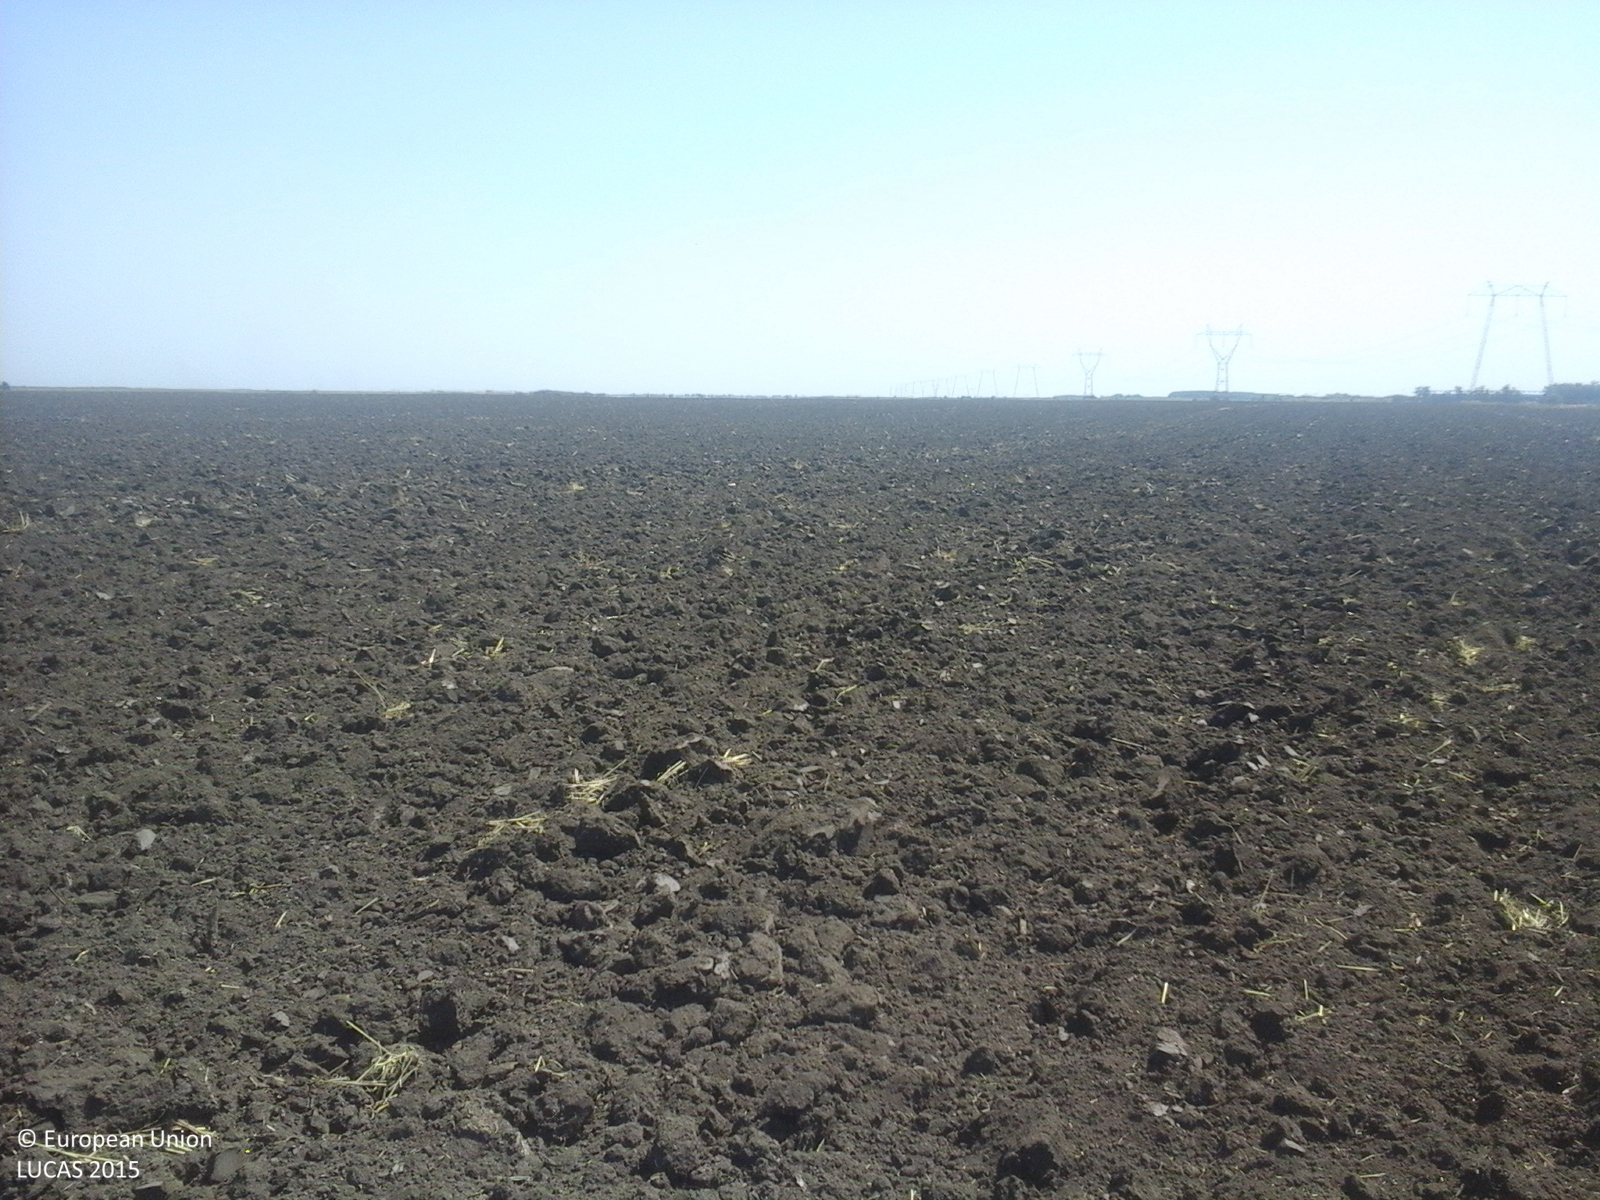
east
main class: Cropland
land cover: Common wheat
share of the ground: < 10 %
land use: Agriculture (excluding fallow land and kitchen gardens)
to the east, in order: Common wheat
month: July
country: RO
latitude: 44.2759
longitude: 27.2351
